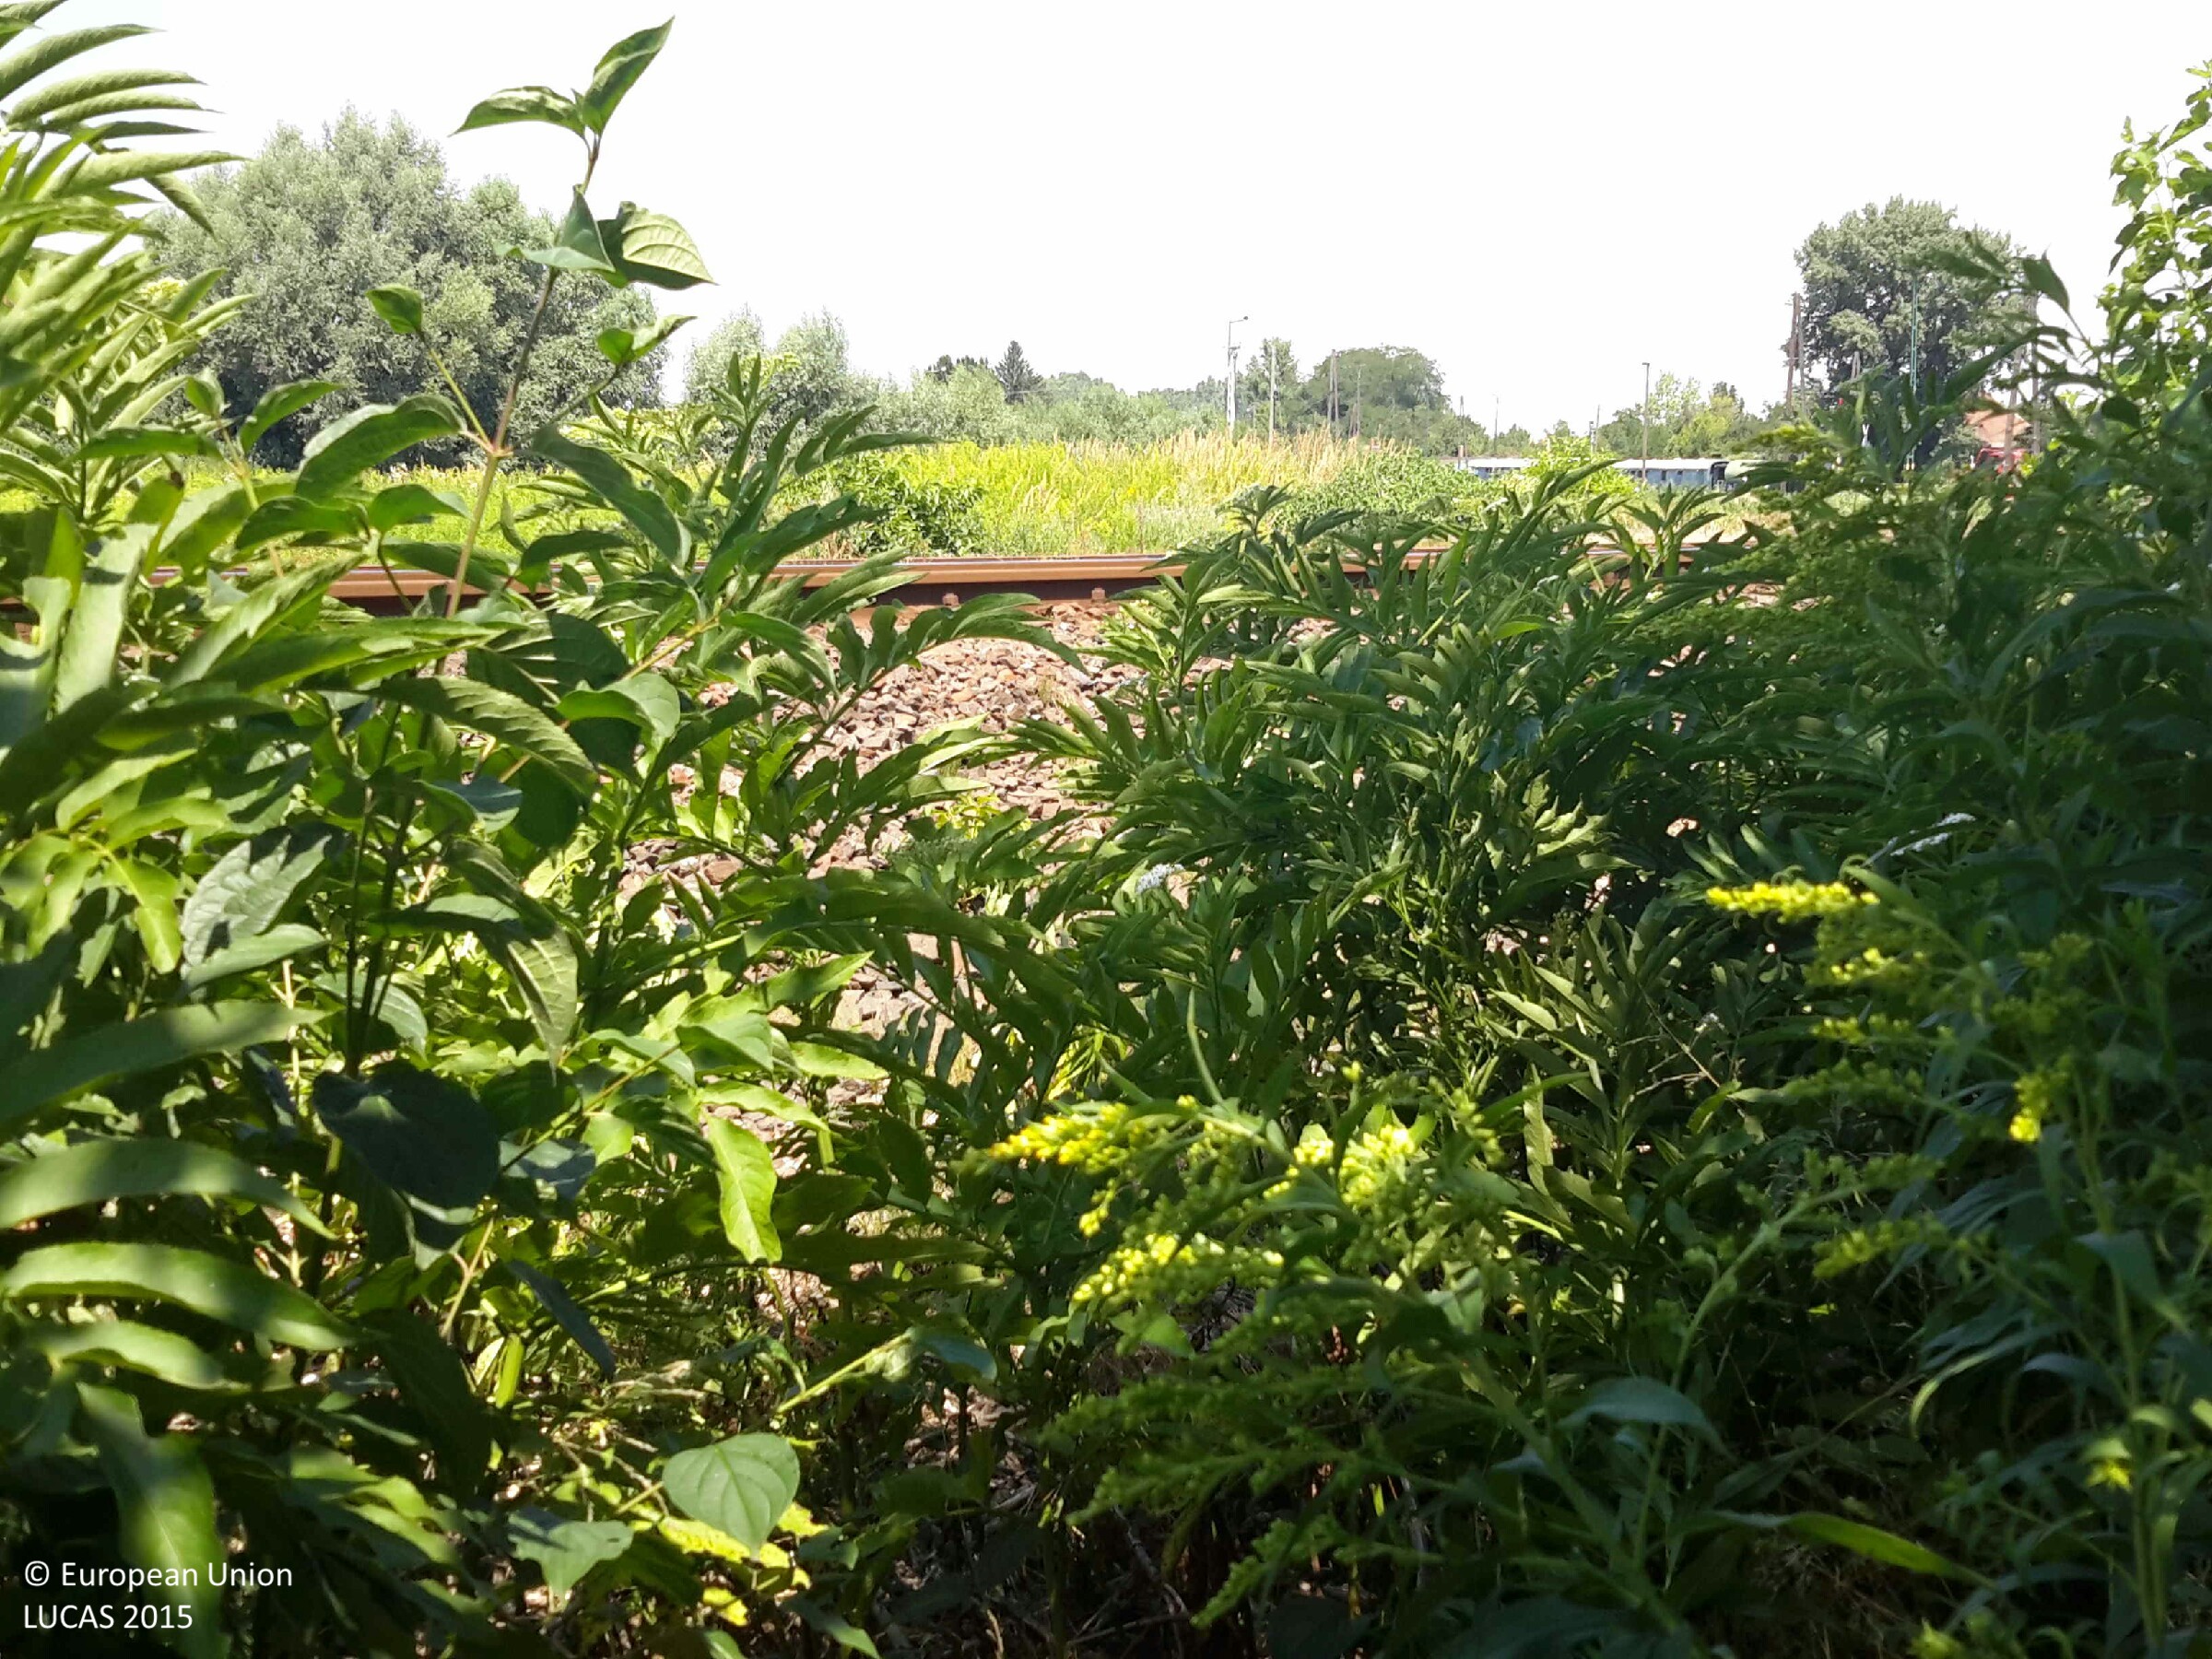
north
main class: Shrubland
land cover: Shrubland with sparse tree cover
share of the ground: 25 - 50 %
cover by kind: herbaceous plants 70 %, shrubs 25 %, broadleaved forest trees 5 %
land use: Semi-natural and natural areas not in use
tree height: > 5 m
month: July
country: HU
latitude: 47.4393
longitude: 17.8197
